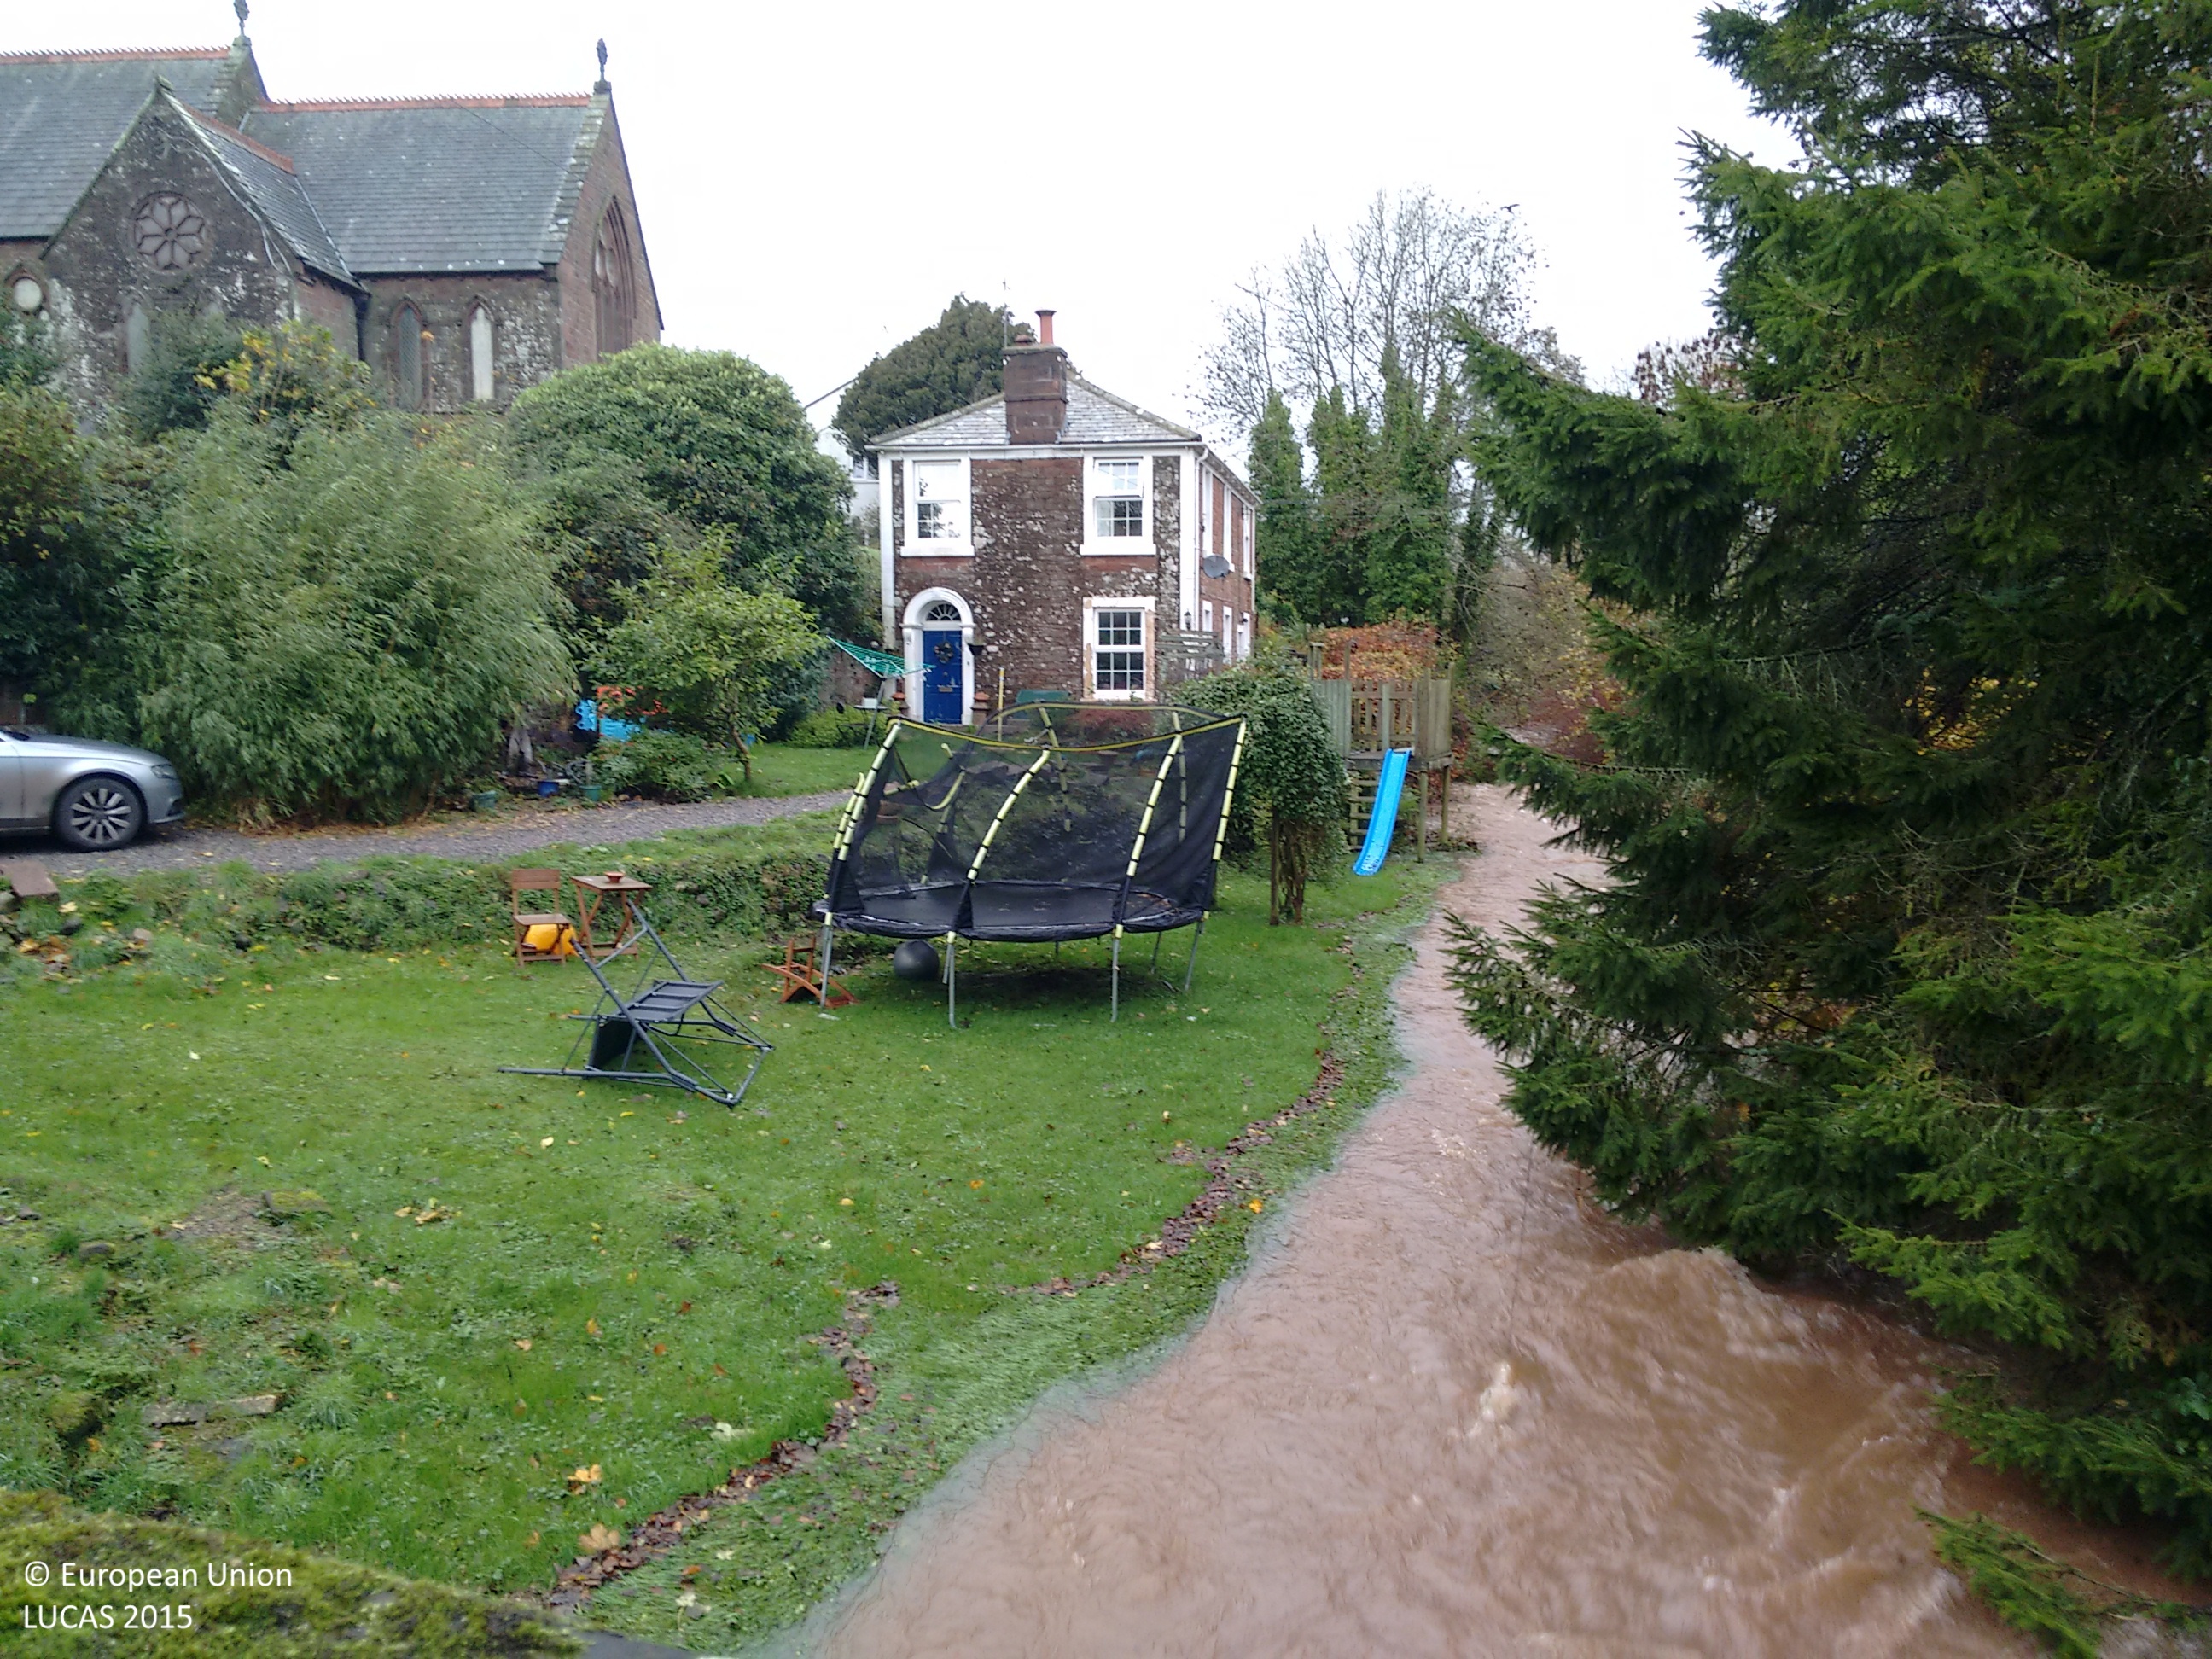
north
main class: Grassland
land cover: Grassland without tree/shrub cover
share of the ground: > 75 %
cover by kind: herbaceous plants 100 %
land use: Residential
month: November
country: GB
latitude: 54.4461
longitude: -3.5141
